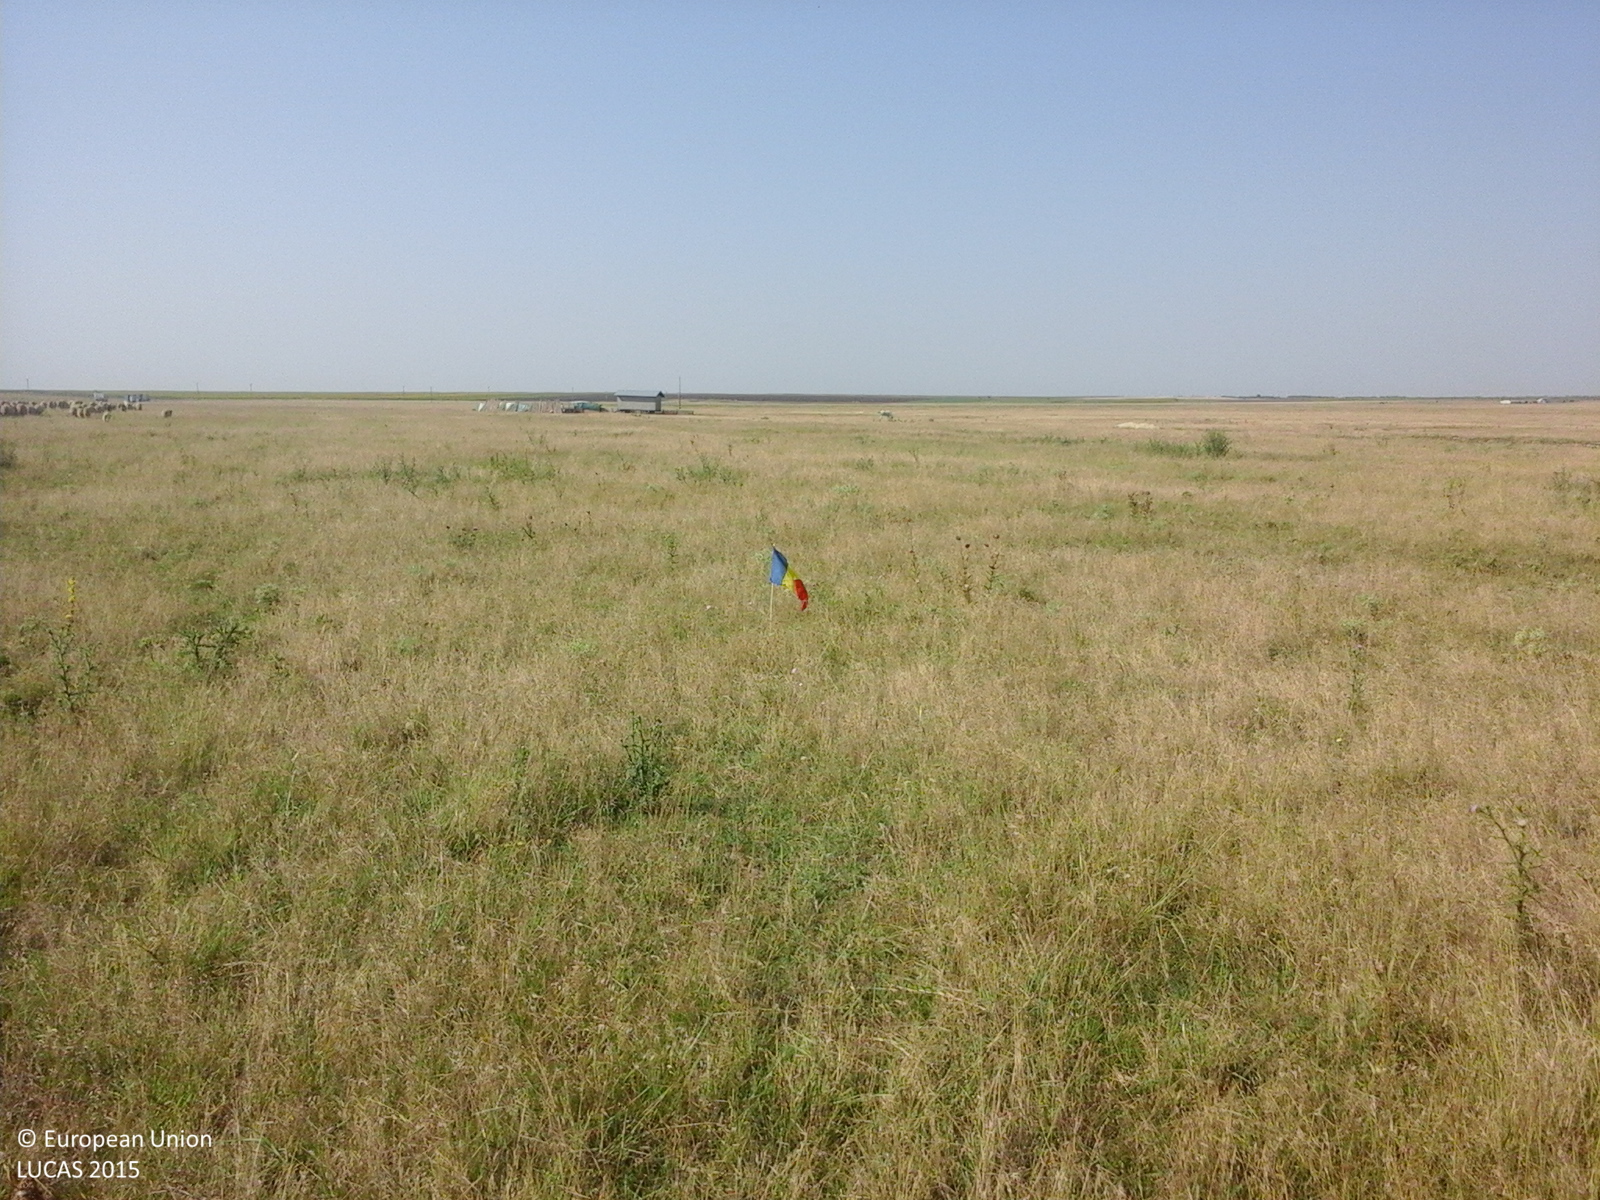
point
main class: Grassland
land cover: Grassland without tree/shrub cover
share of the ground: > 75 %
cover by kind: herbaceous plants 100 %
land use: Agriculture (excluding fallow land and kitchen gardens)
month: July
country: RO
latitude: 44.8129
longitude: 27.3256
